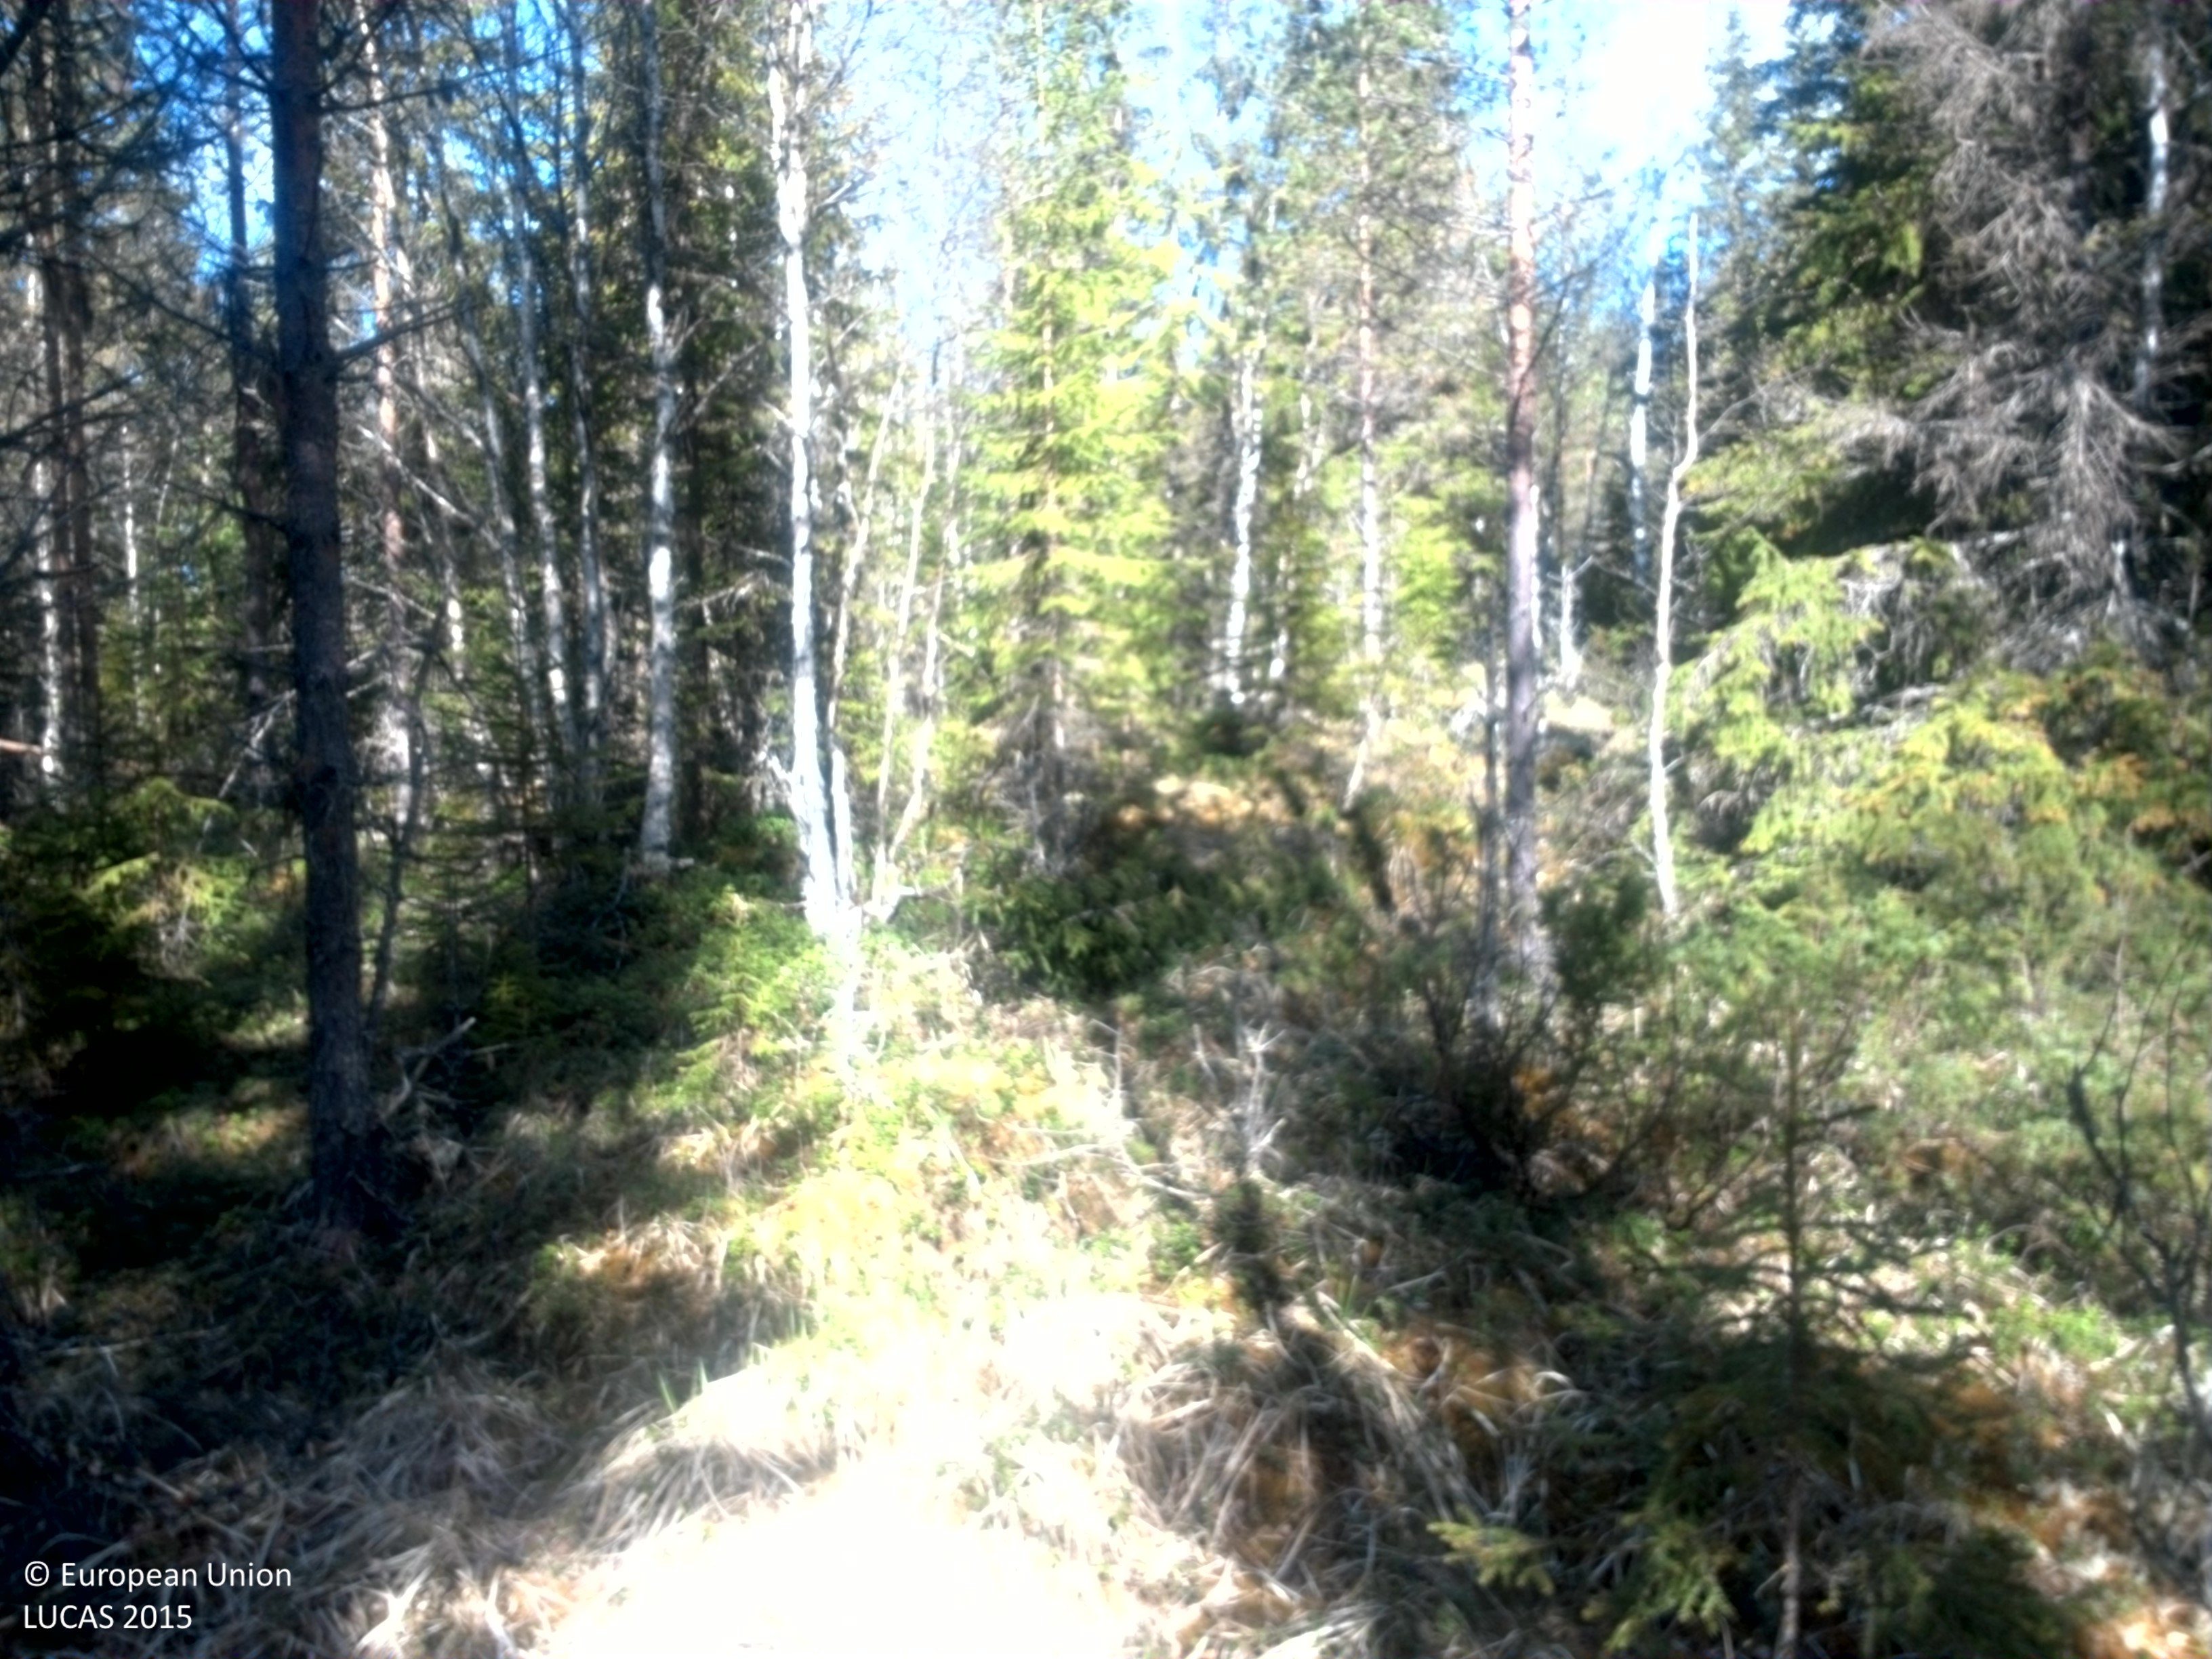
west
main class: Woodland
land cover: Other mixed woodland
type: boreal forest
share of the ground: 50 - 75 %
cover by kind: coniferous forest trees 50 %, broadleaved forest trees 20 %, shrubs 15 %, herbaceous plants 15 %
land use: Forestry
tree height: > 5 m
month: May
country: SE
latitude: 63.3057
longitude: 15.0251
